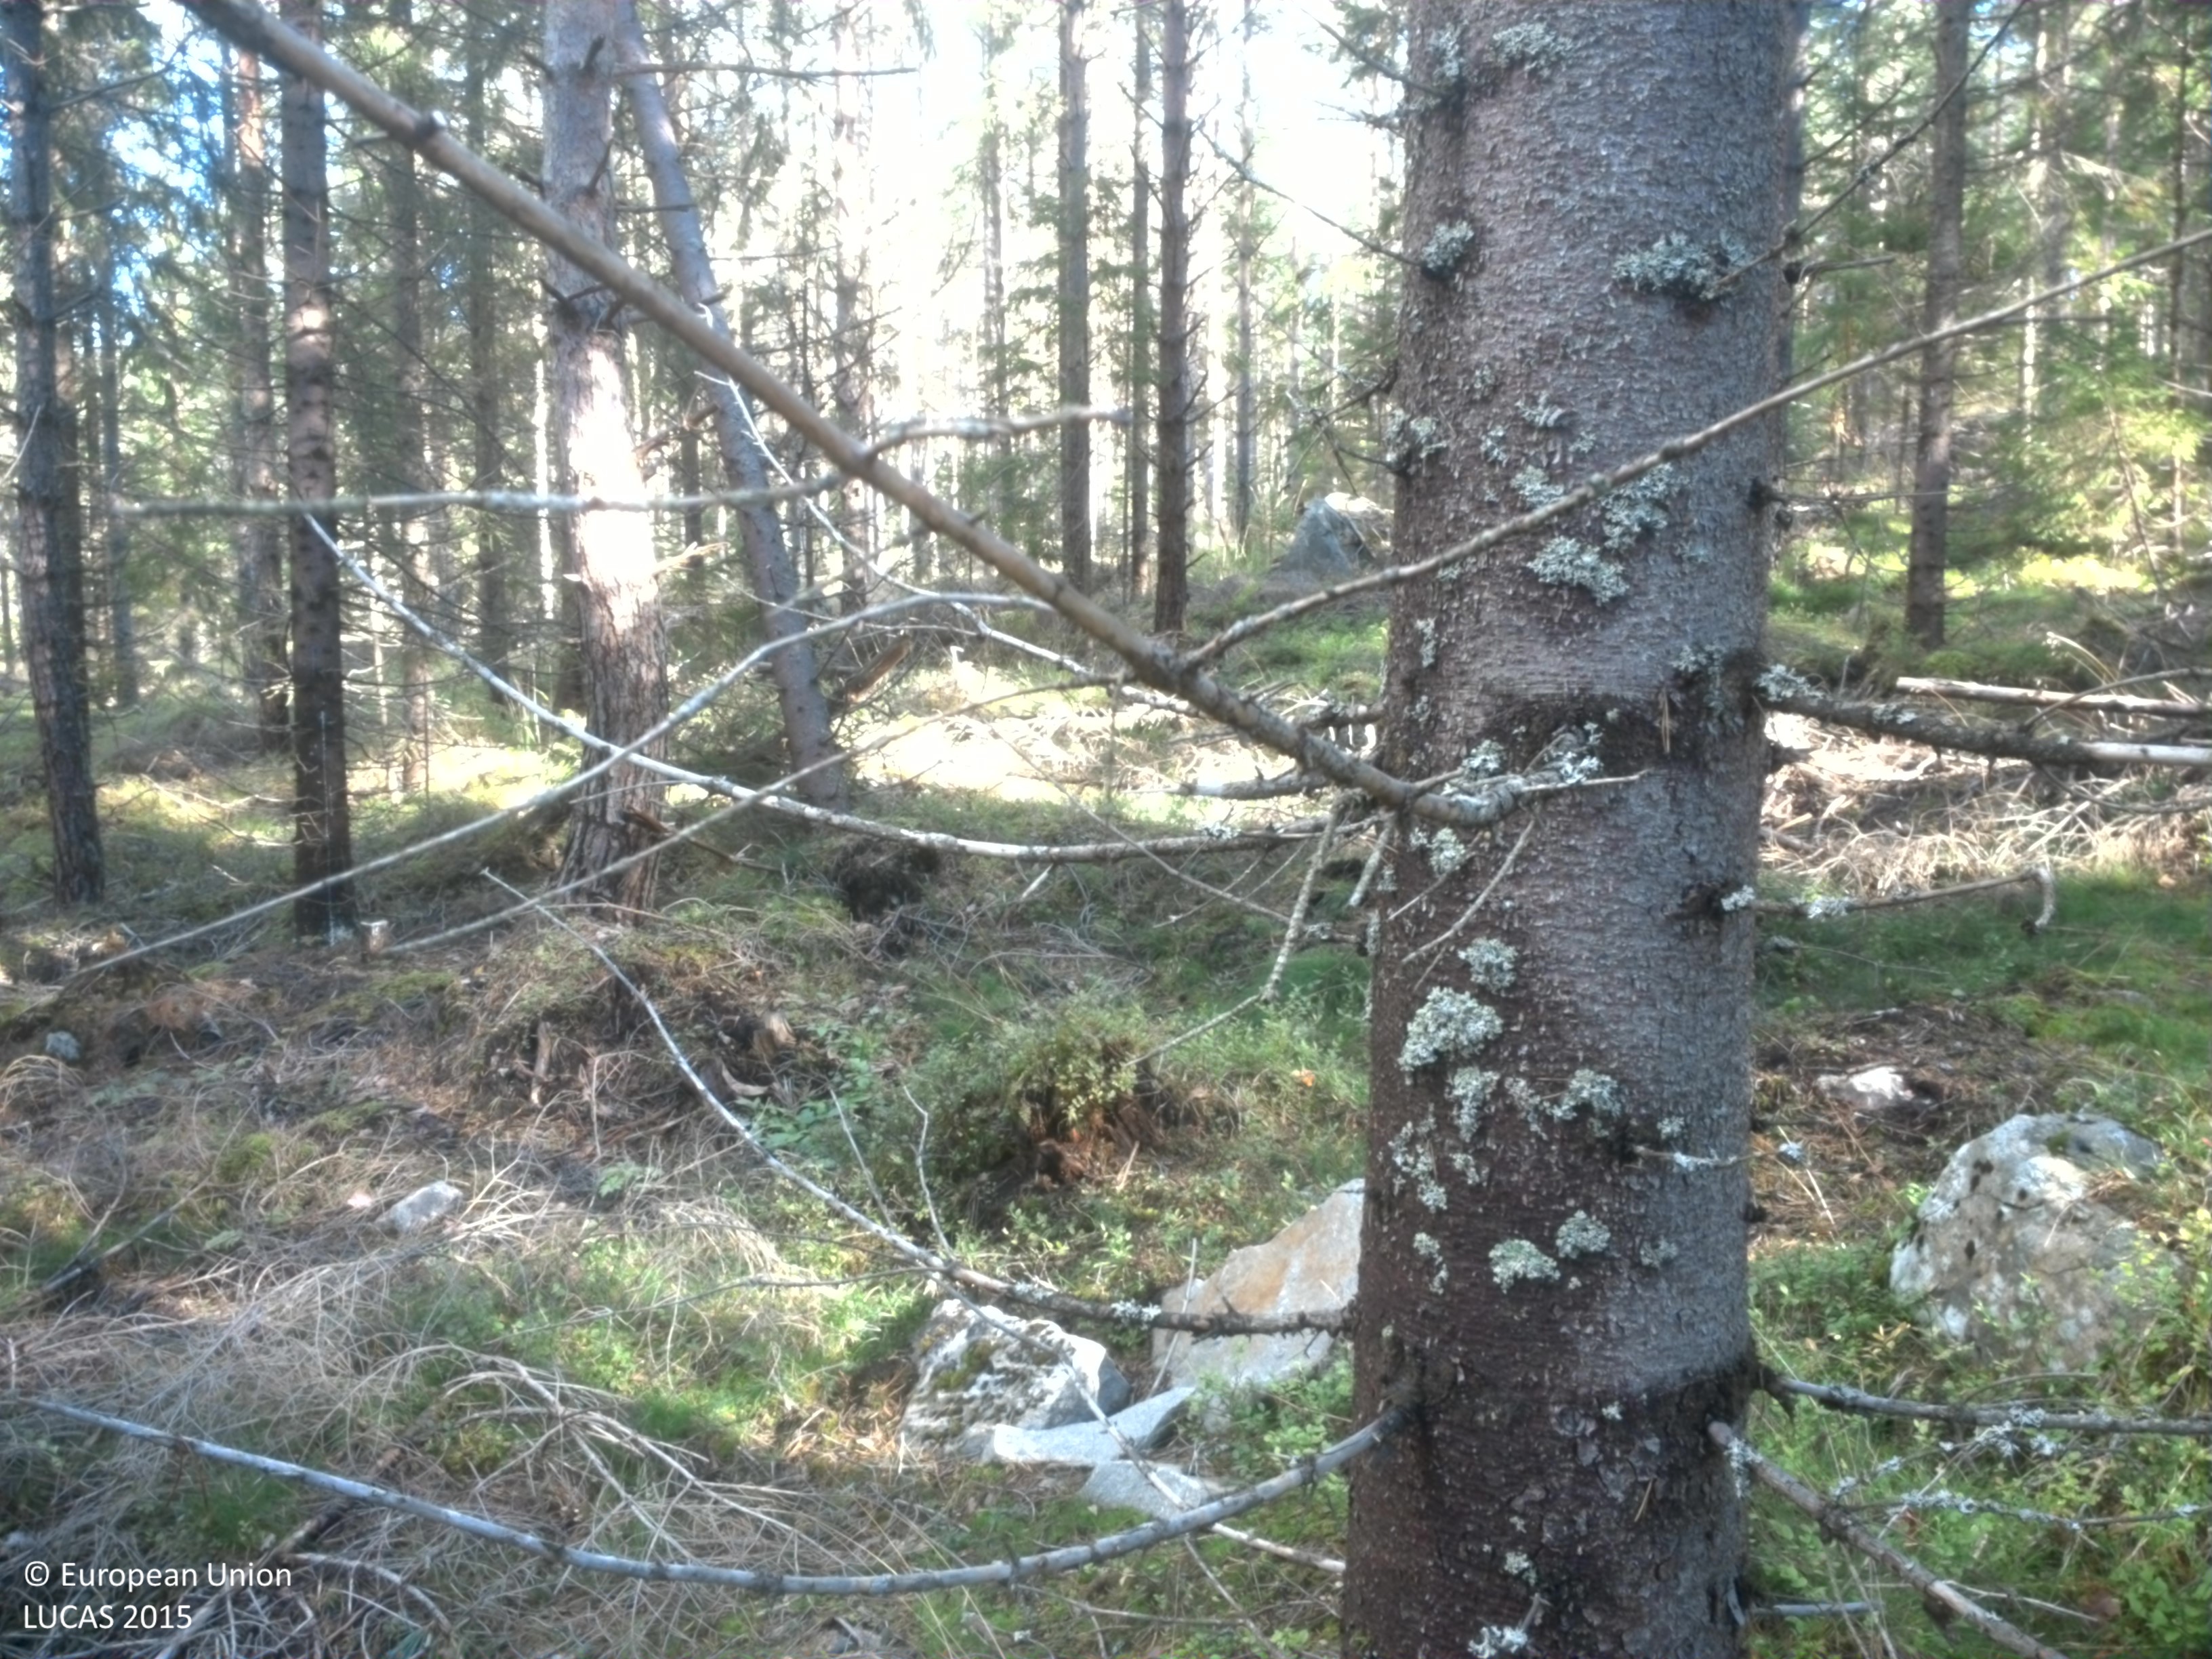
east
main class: Woodland
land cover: Other coniferous woodland
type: boreal forest
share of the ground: > 75 %
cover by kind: coniferous forest trees 75 %, shrubs 10 %, lichens and mosses 10 %, herbaceous plants 5 %
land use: Forestry
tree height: > 5 m
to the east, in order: Other coniferous woodland; Tracks; Other coniferous woodland; Tracks; Pine dominated coniferous woodland; Tracks; Pine dominated coniferous woodland; Tracks; Pine dominated coniferous woodland; Spruce dominated coniferous woodland; Pine dominated coniferous woodland
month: September
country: SE
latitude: 59.8925
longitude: 15.5123
